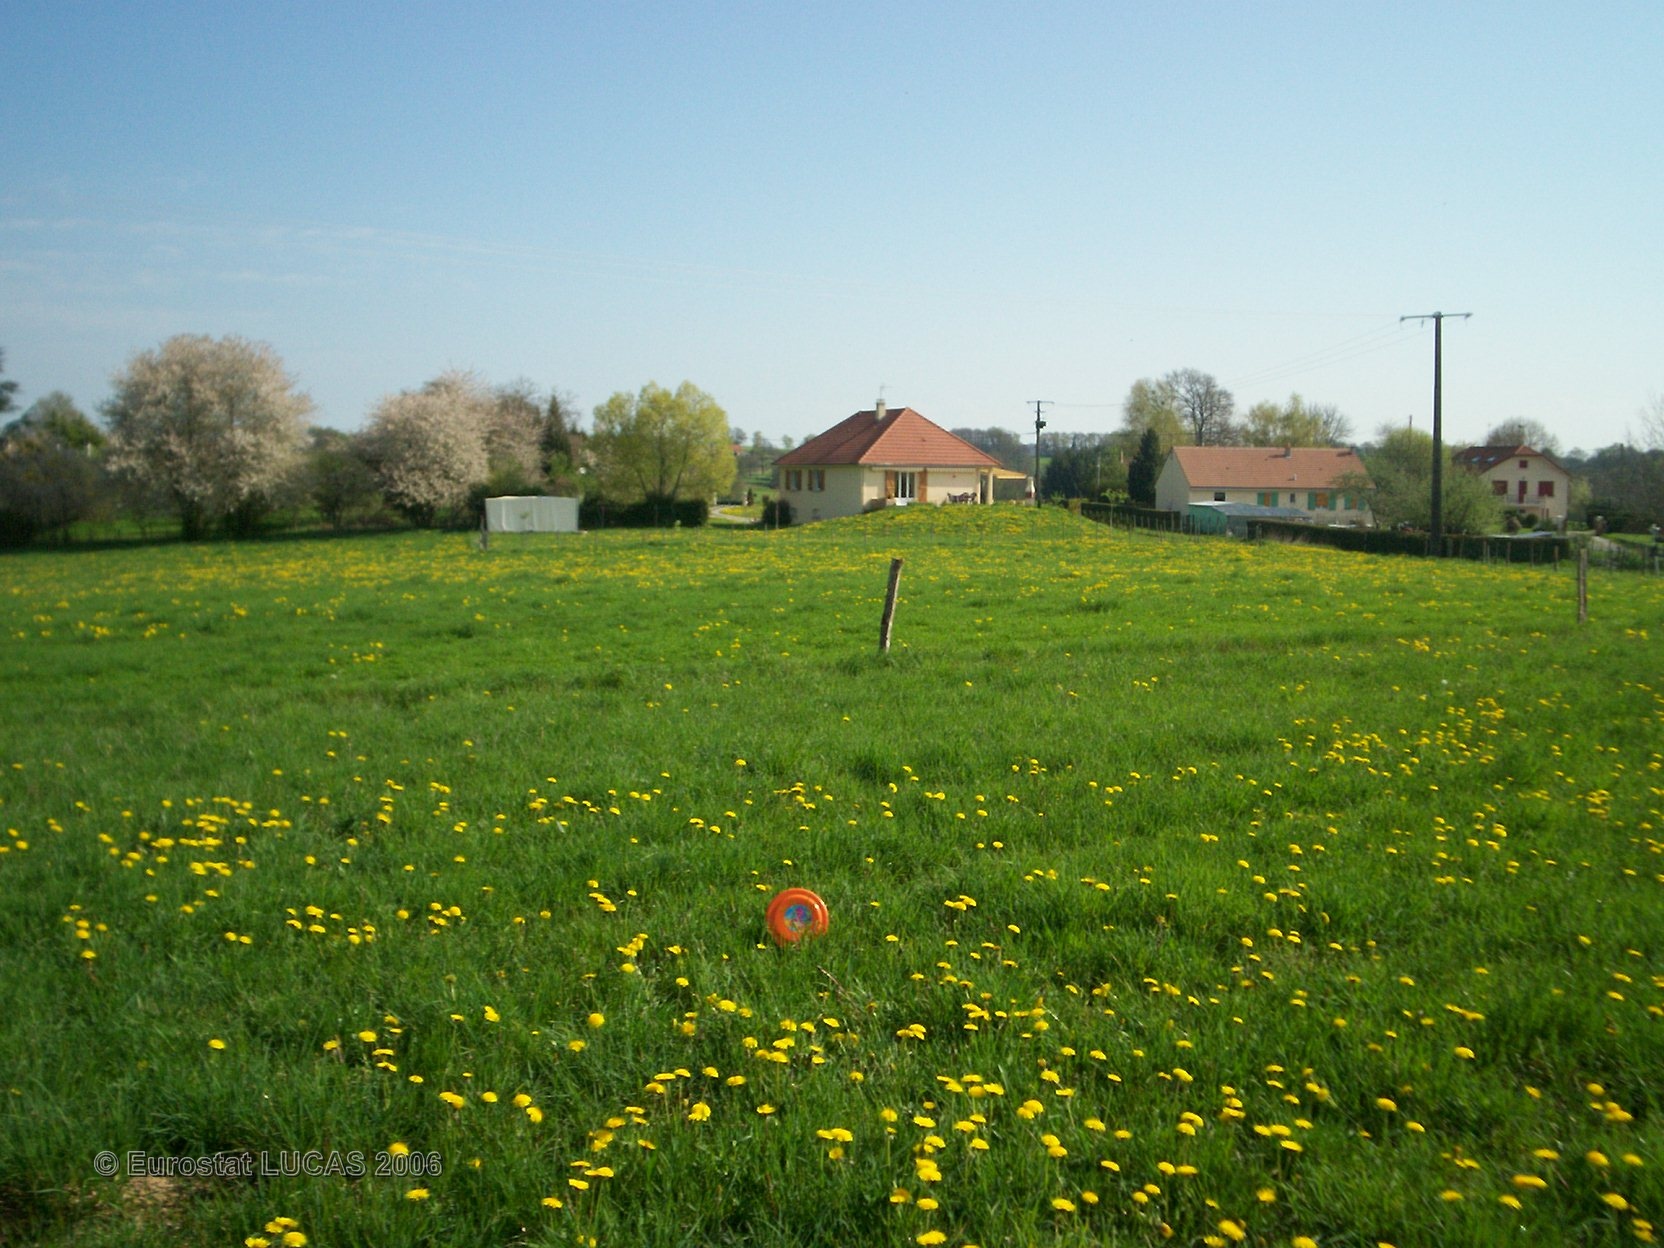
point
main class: Grassland
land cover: Grassland with sparse tree/shrub cover
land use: Agriculture (excluding fallow land and kitchen gardens)
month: April
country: FR
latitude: 46.1559
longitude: 1.4835
